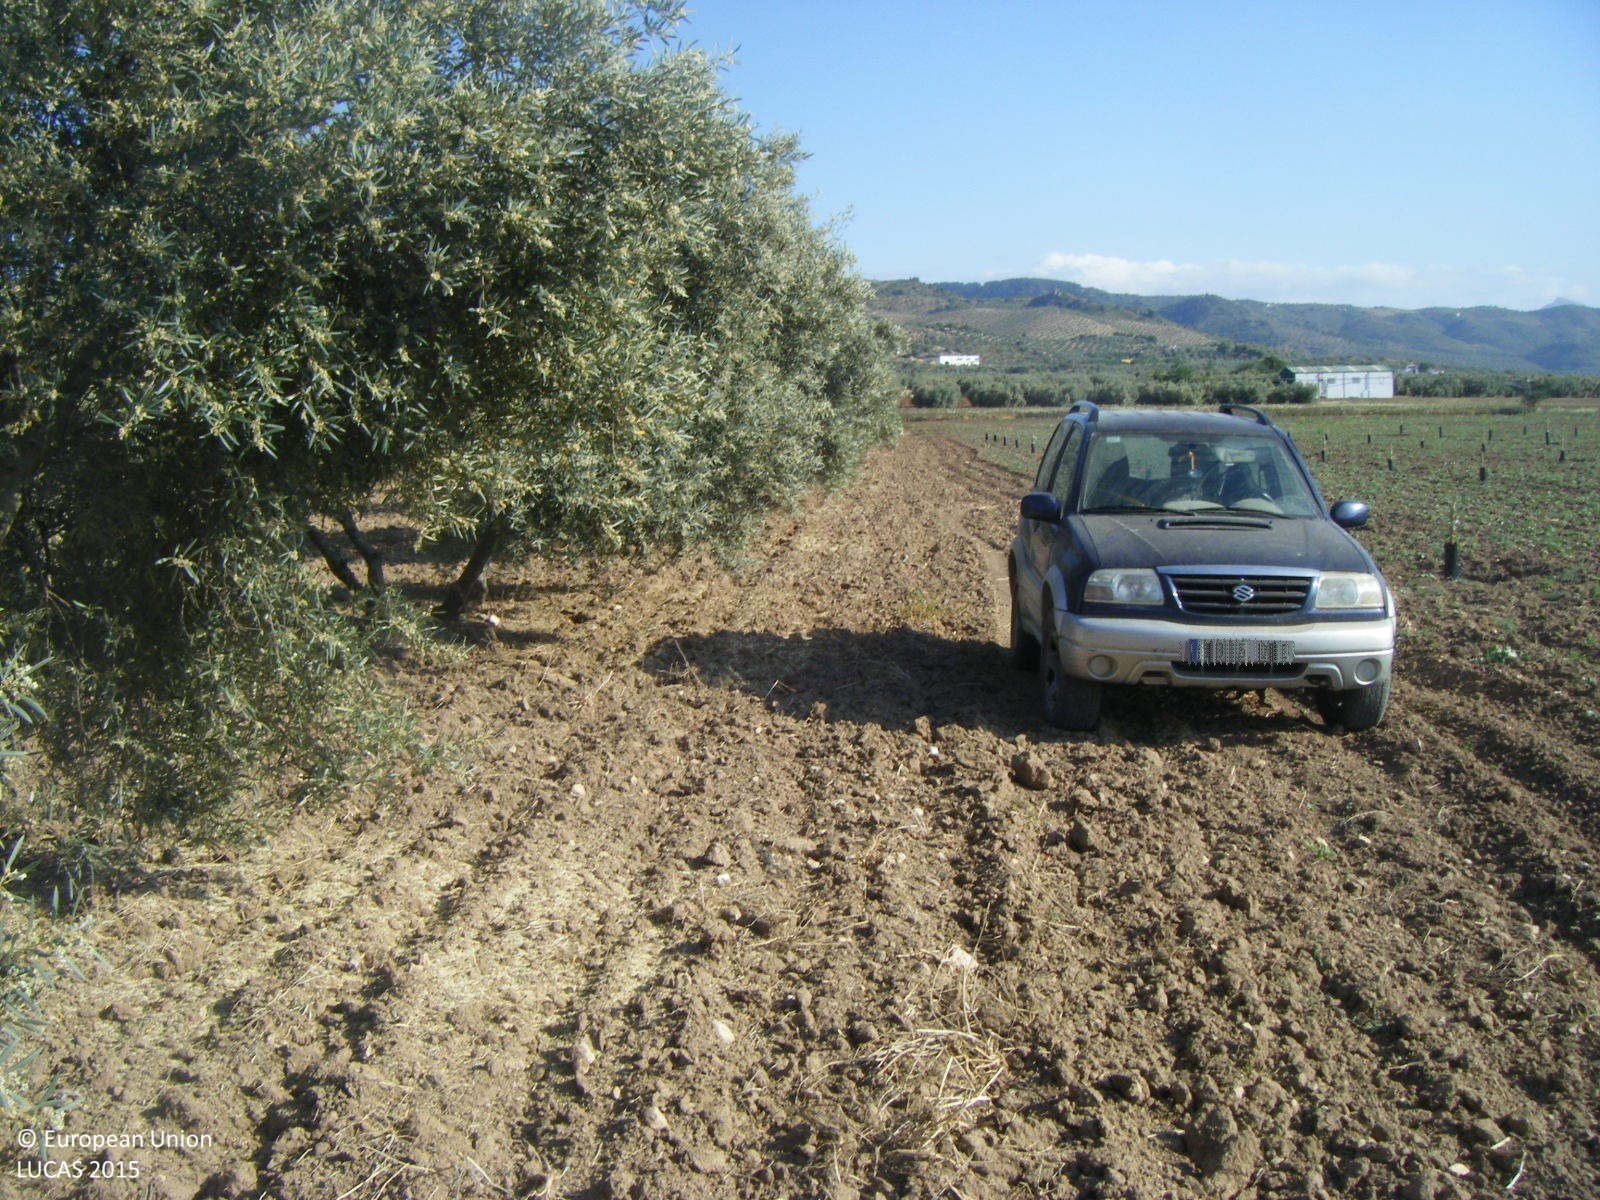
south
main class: Cropland
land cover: Olive groves
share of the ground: 25 - 50 %
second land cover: Other bare soil
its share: > 75 %
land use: Agriculture (excluding fallow land and kitchen gardens)
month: May
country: ES
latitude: 37.1034
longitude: -4.4106
